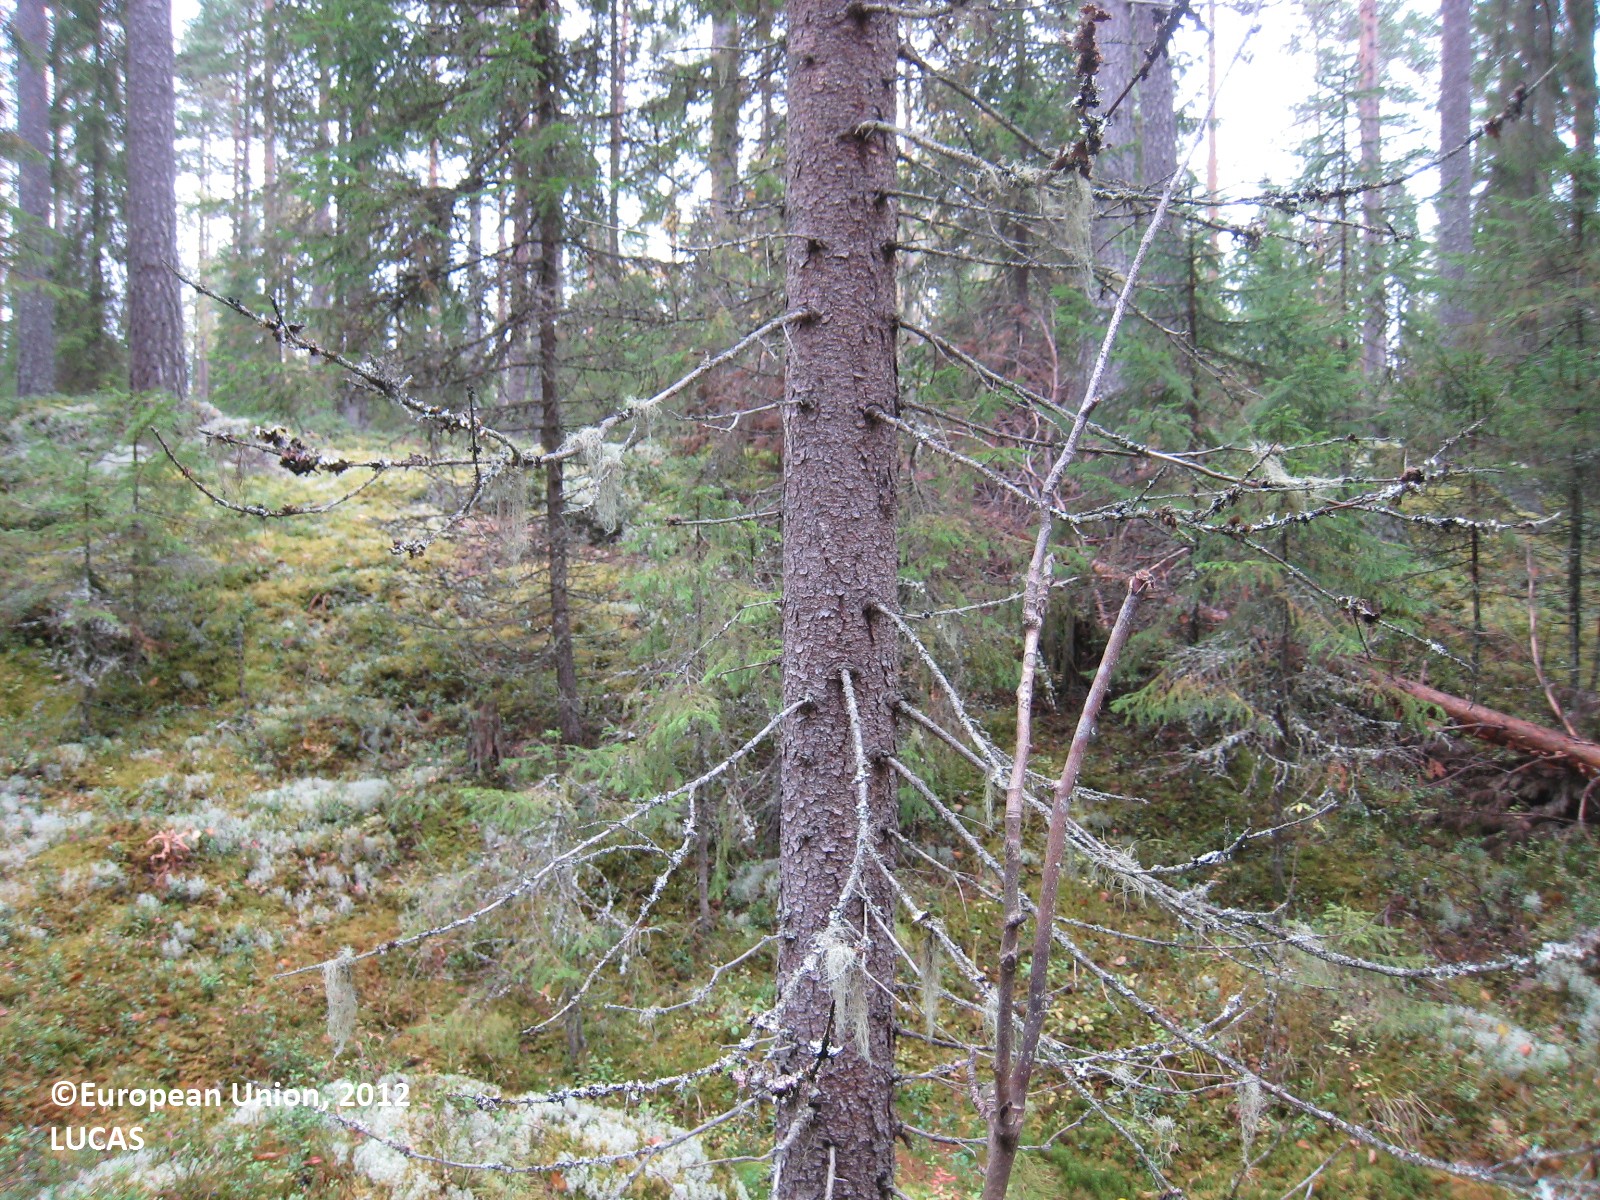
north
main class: Woodland
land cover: Other coniferous woodland
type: boreal forest
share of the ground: > 75 %
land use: Forestry
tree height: > 5 m
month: September
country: FI
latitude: 62.7258
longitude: 26.1859
